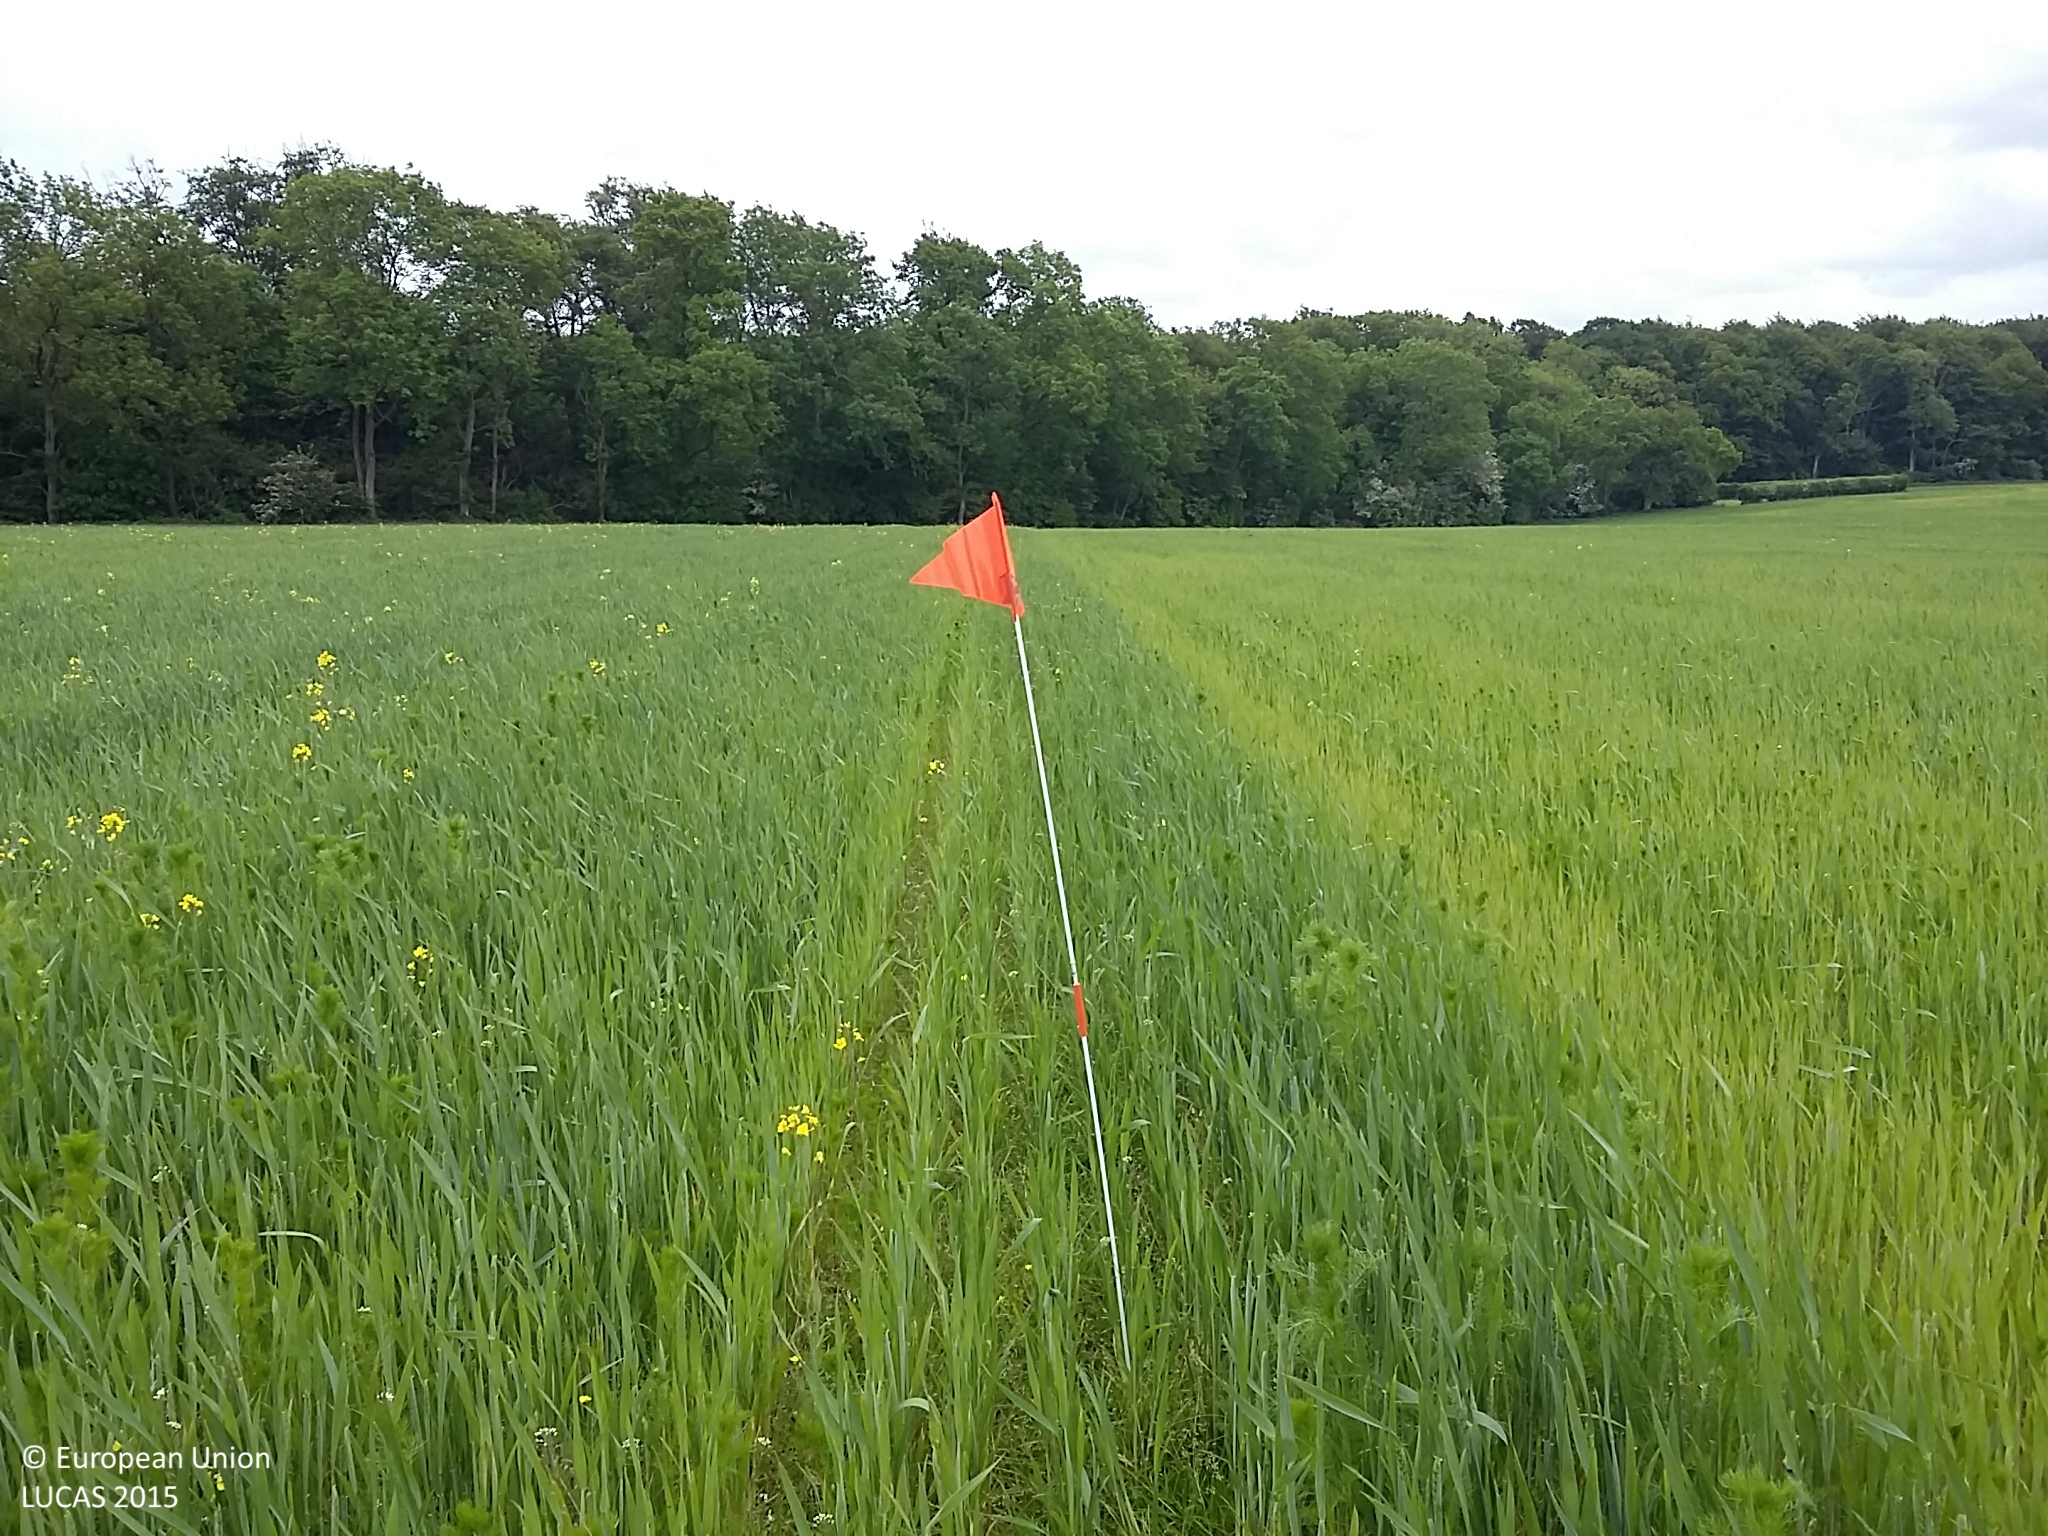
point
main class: Cropland
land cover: Common wheat
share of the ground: > 75 %
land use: Agriculture (excluding fallow land and kitchen gardens)
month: June
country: DK
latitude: 55.4310
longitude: 10.6789
